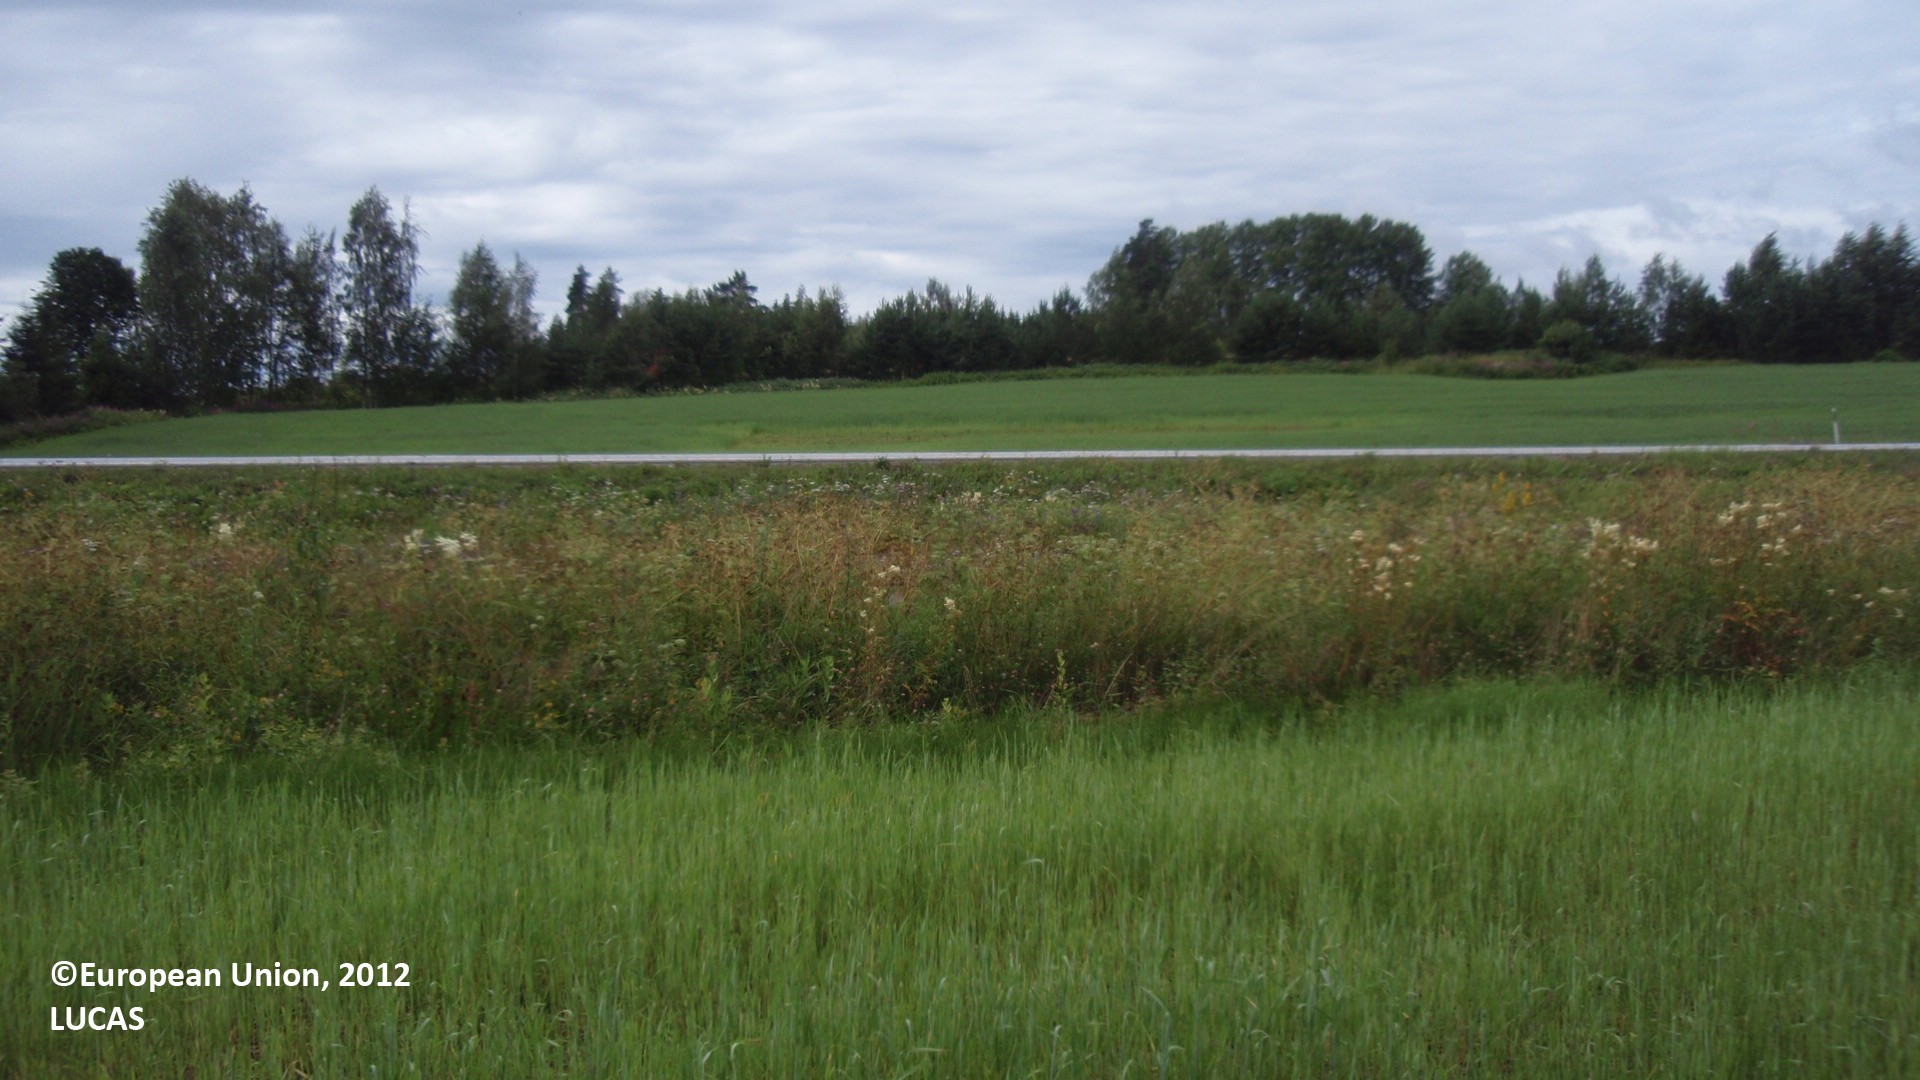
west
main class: Cropland
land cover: Rye
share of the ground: 50 - 75 %
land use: Agriculture (excluding fallow land and kitchen gardens)
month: July
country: FI
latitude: 61.4939
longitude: 27.2433
